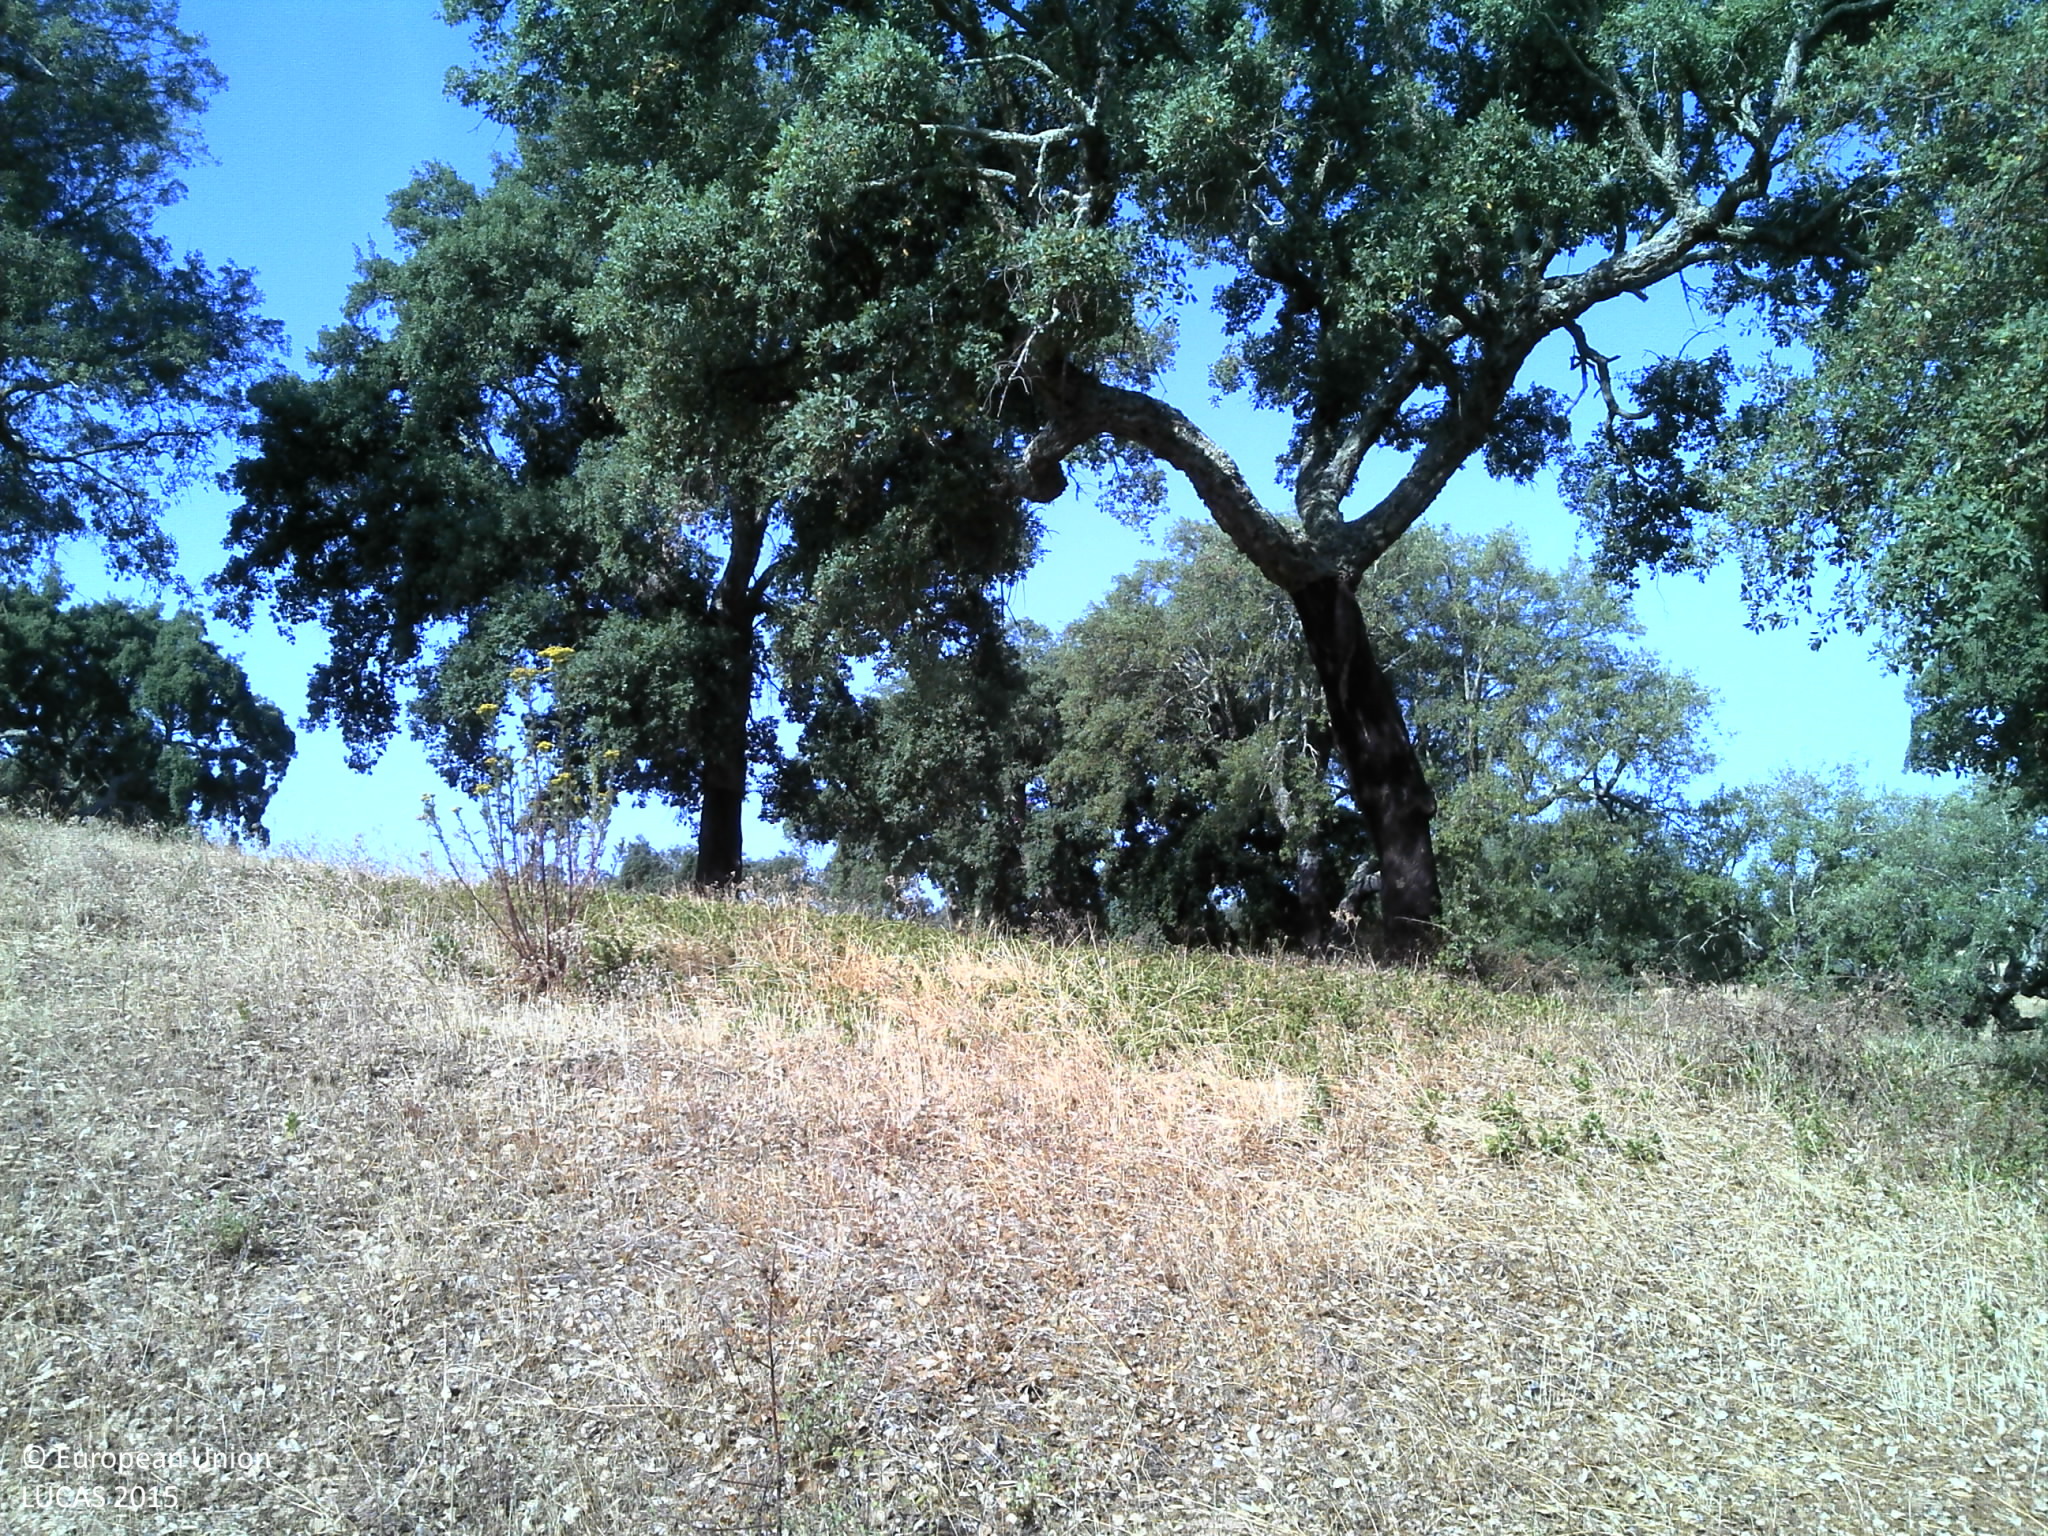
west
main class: Woodland
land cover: Broadleaved woodland
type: broadleaved evergreen forest
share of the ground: 10 - 25 %
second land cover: Grassland without tree/shrub cover
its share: 25 - 50 %
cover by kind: unconsolidated bare surface 50 %, herbaceous plants 30 %, broadleaved forest trees 20 %
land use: Forestry
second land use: Agriculture (excluding fallow land and kitchen gardens)
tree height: > 5 m
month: July
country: PT
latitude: 38.3646
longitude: -7.8072
